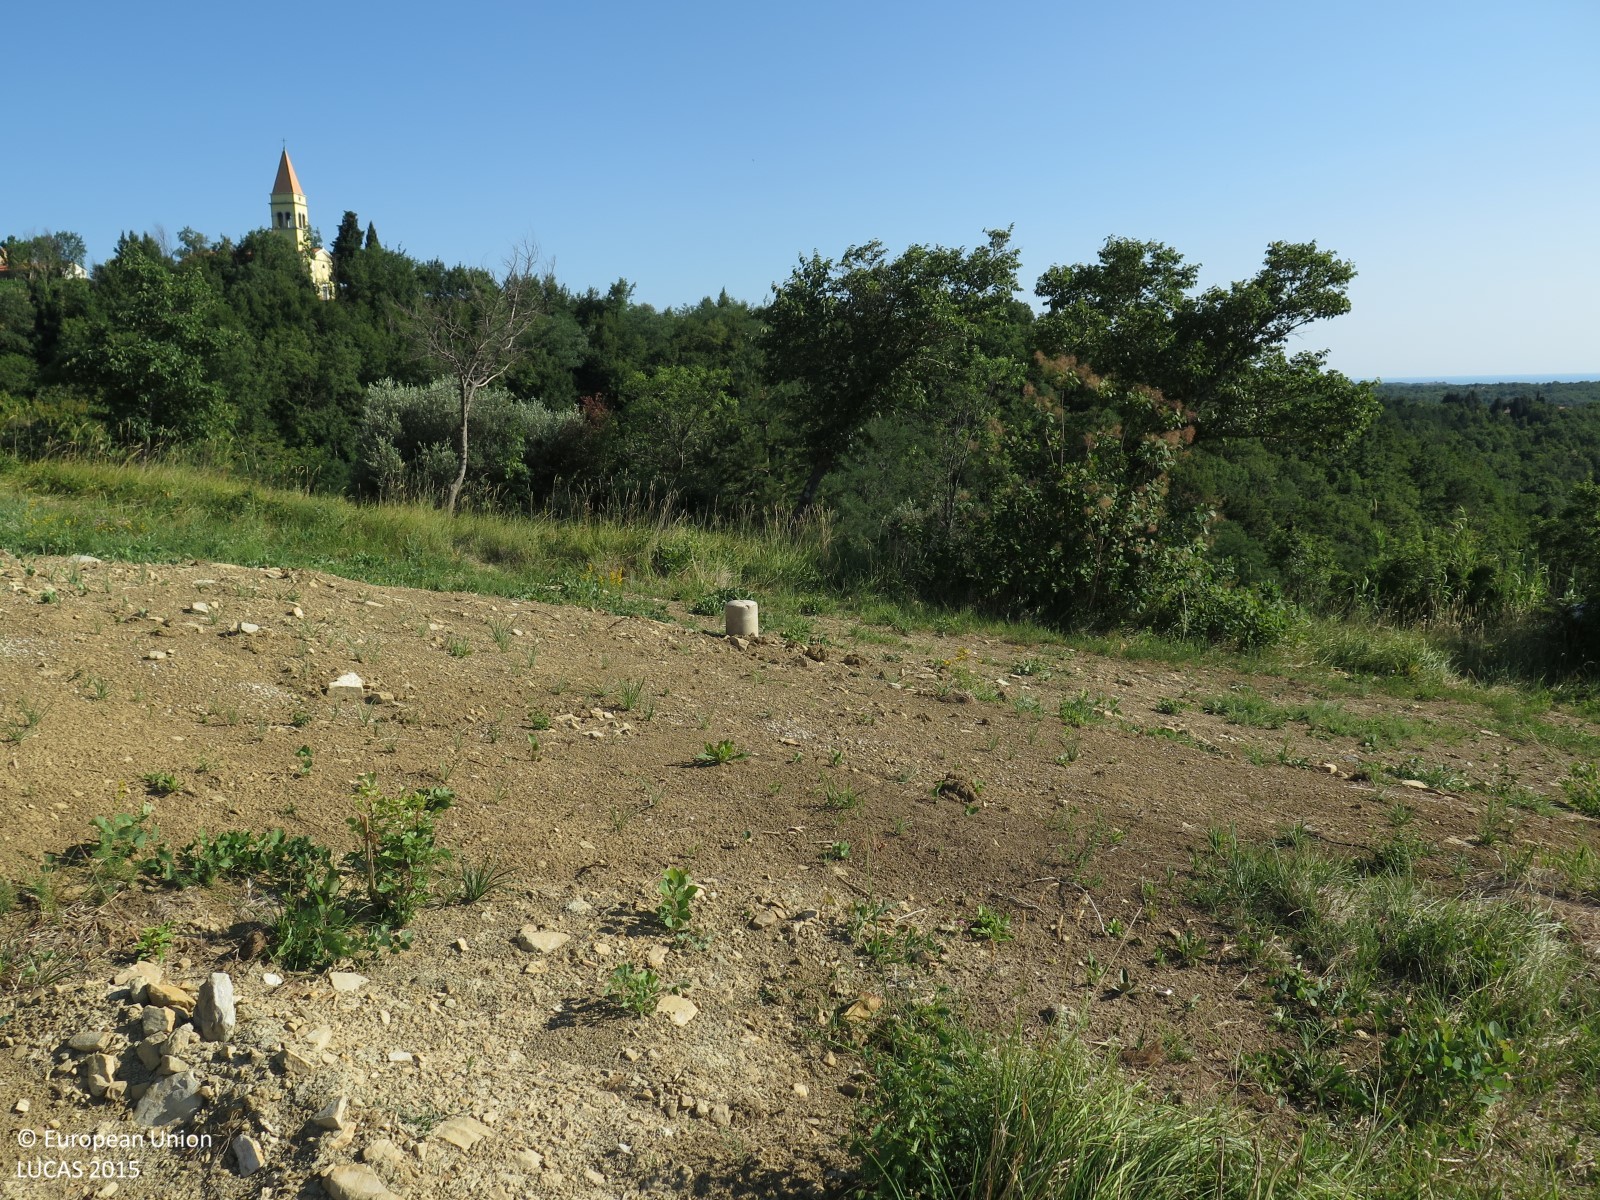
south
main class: Grassland
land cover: Grassland with sparse tree/shrub cover
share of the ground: 50 - 75 %
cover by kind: herbaceous plants 90 %, coniferous forest trees 5 %, shrubs 5 %
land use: Abandoned areas
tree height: < 5 m
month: July
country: HR
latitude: 45.4391
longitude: 13.7153
